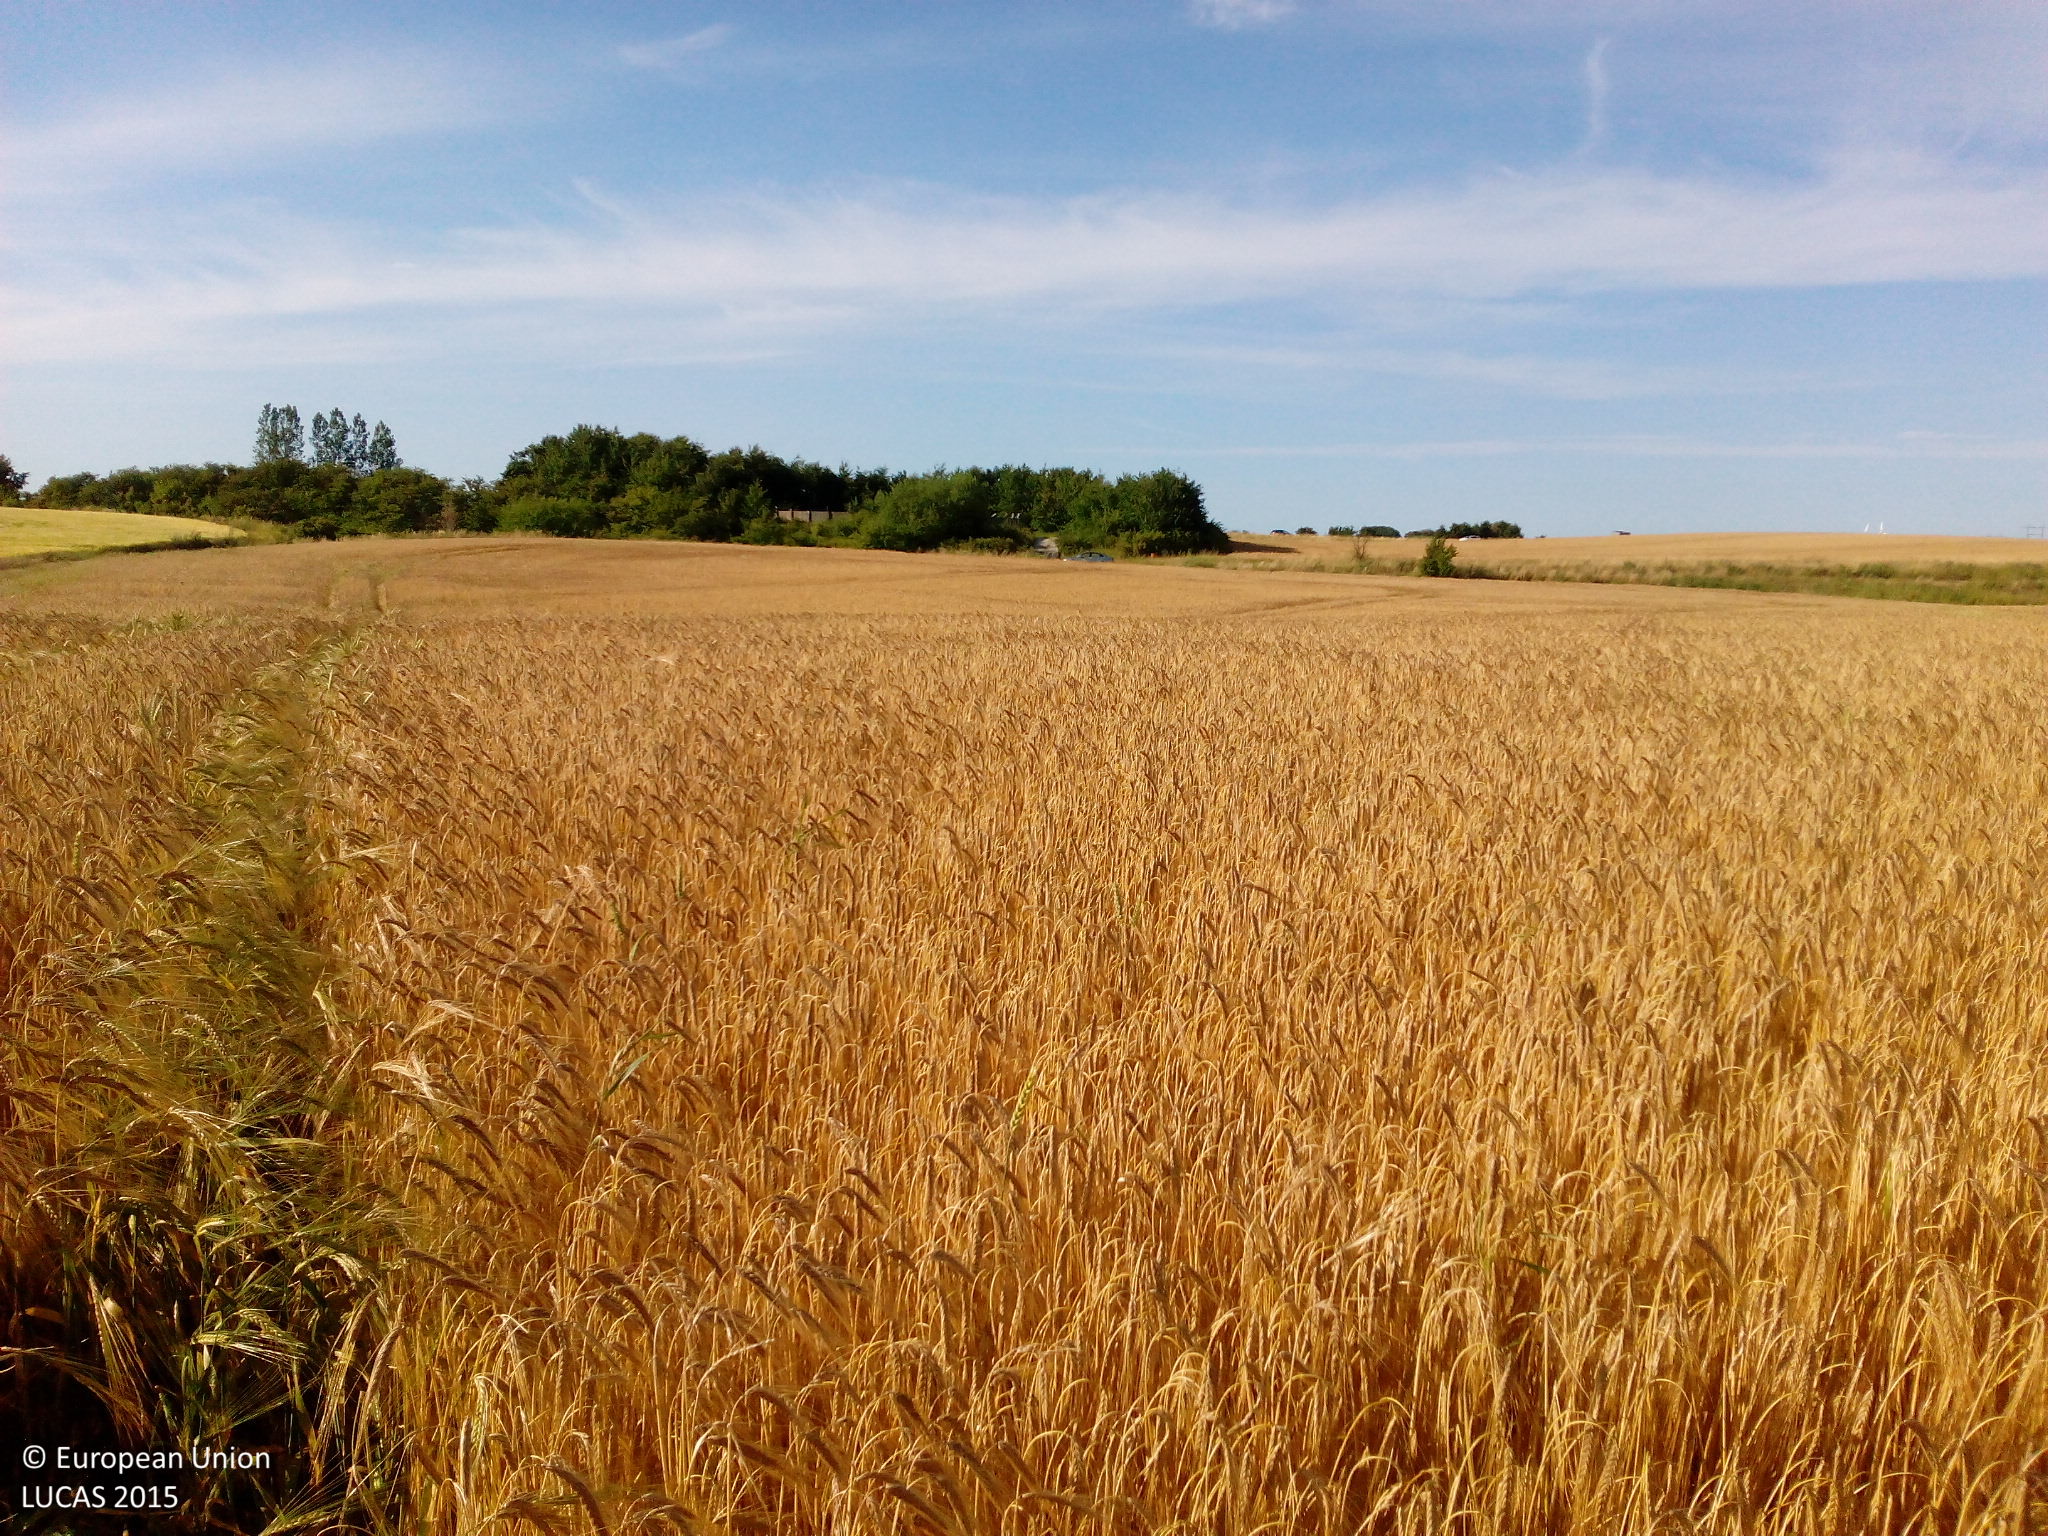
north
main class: Cropland
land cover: Barley
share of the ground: > 75 %
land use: Agriculture (excluding fallow land and kitchen gardens)
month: July
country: DK
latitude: 55.6555
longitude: 11.6673
